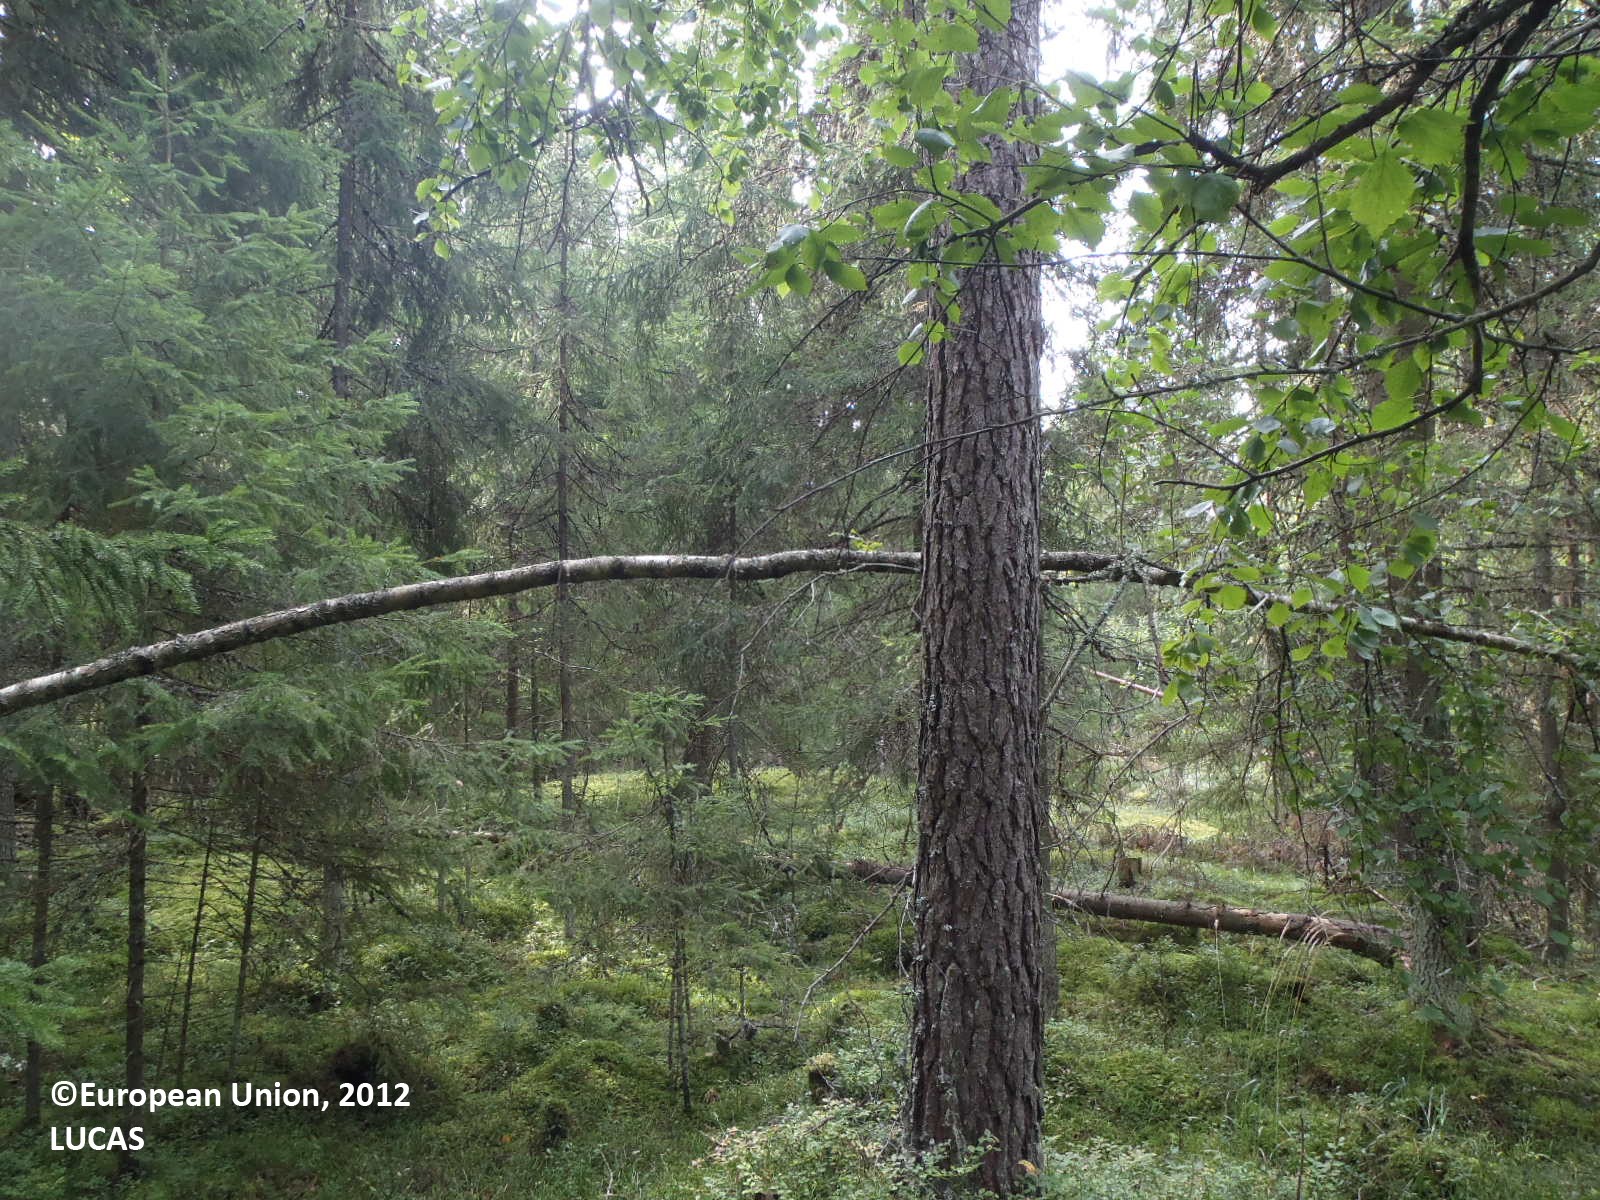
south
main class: Woodland
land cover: Spruce dominated coniferous woodland
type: boreal forest
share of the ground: 50 - 75 %
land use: Forestry
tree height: > 5 m
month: August
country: FI
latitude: 60.8093
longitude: 22.2884
